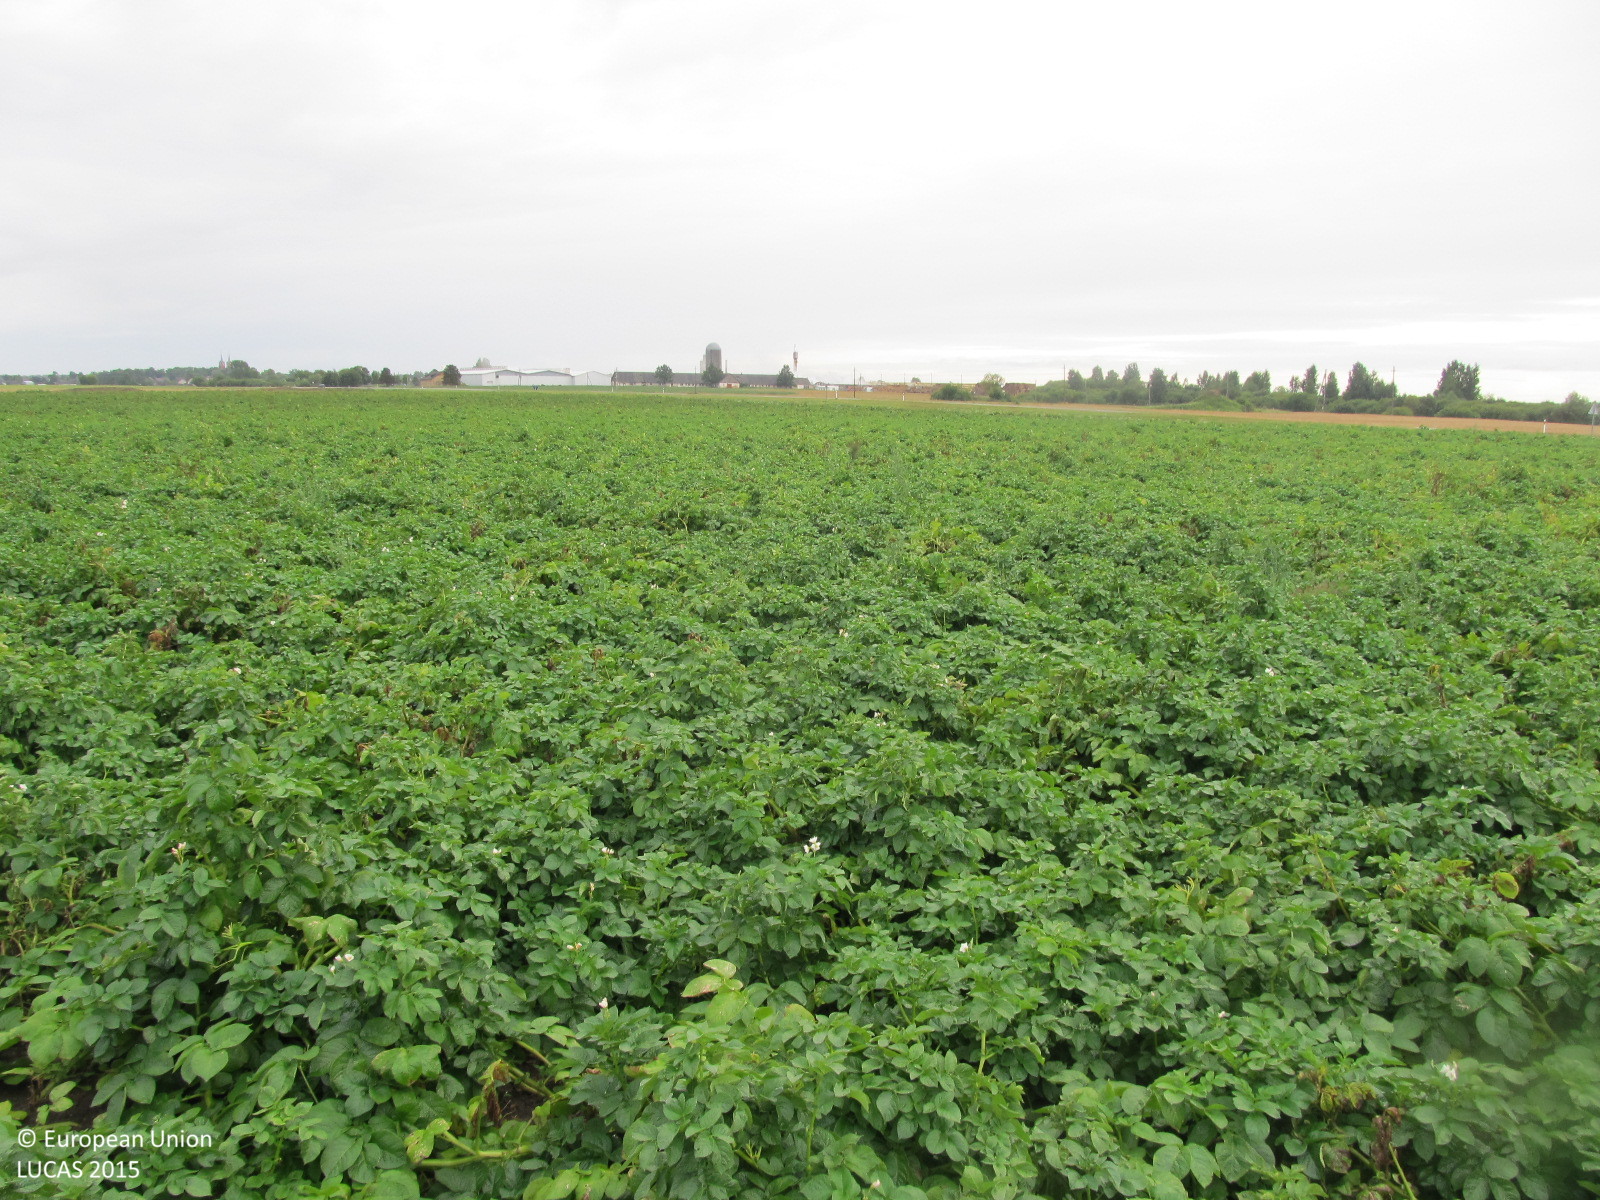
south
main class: Cropland
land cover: Potatoes
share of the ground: > 75 %
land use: Agriculture (excluding fallow land and kitchen gardens)
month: September
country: LT
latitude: 56.1177
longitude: 23.2444
